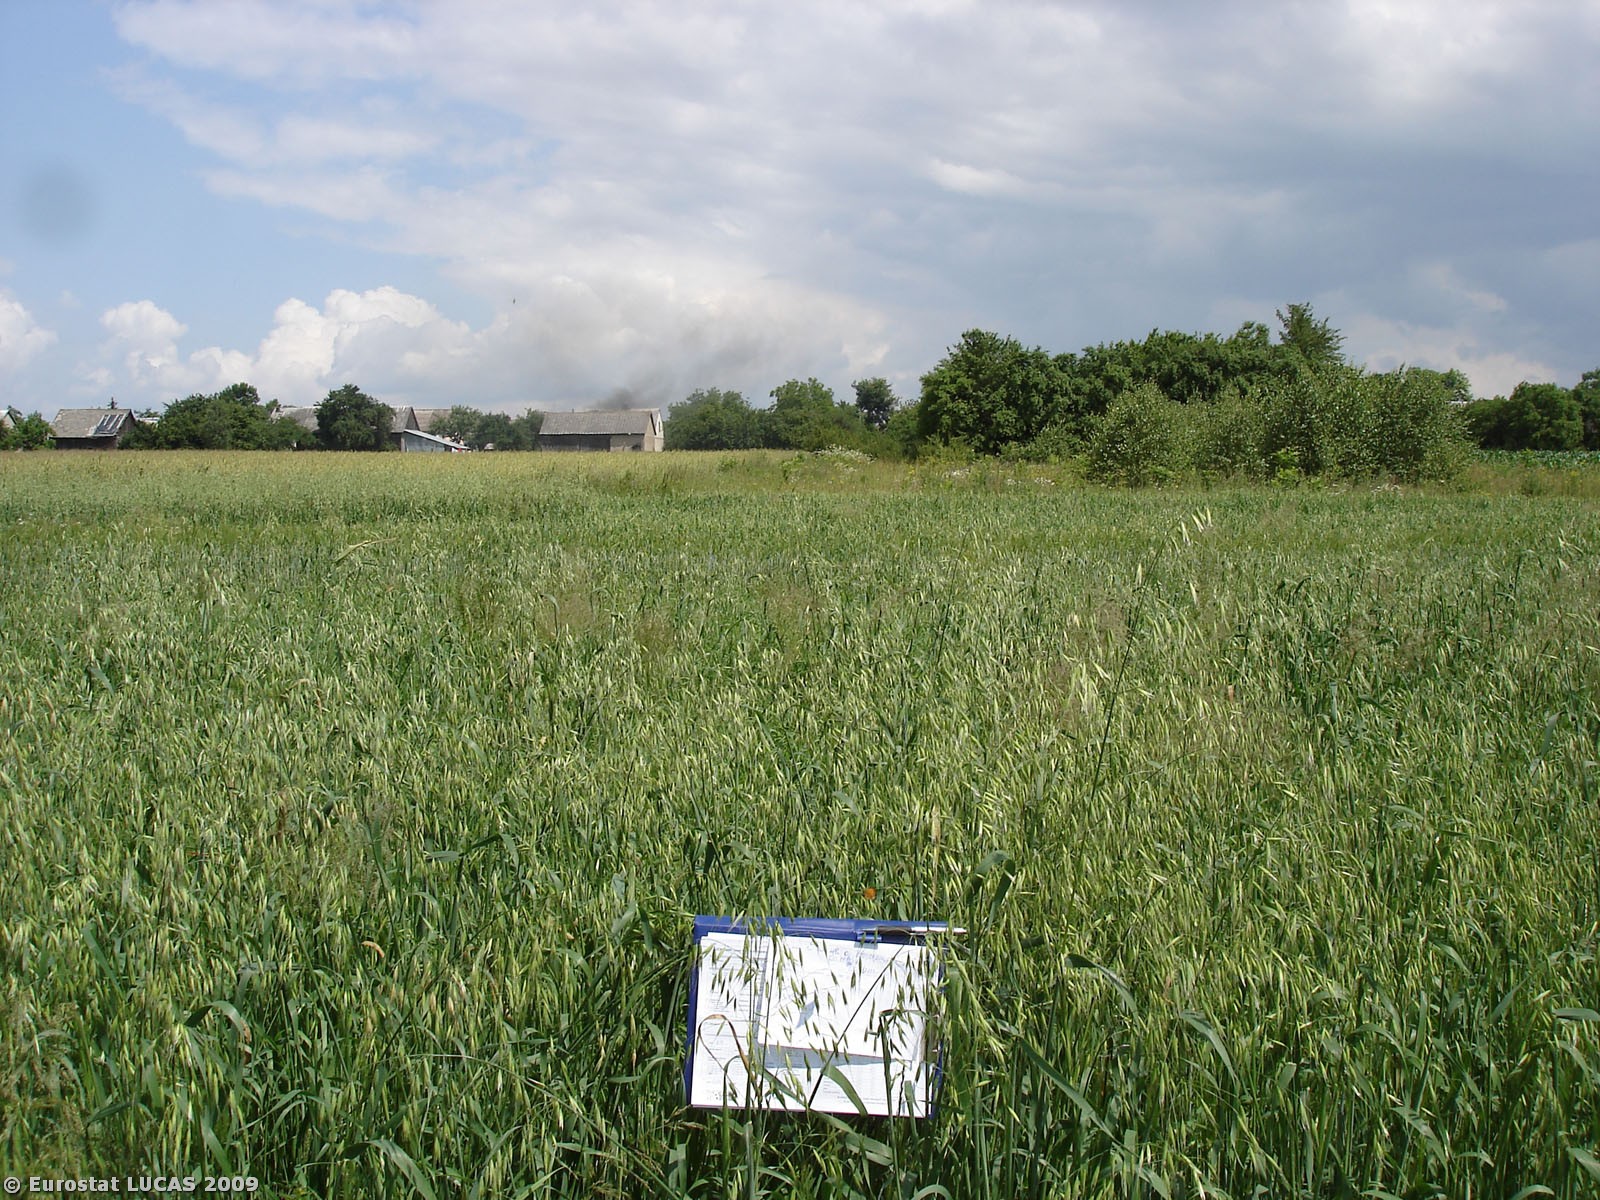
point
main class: Cropland
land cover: Oats
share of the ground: > 75 %
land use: Agriculture (excluding fallow land and kitchen gardens)
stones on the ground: < 10 %
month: June
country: PL
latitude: 50.6816
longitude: 19.8389
